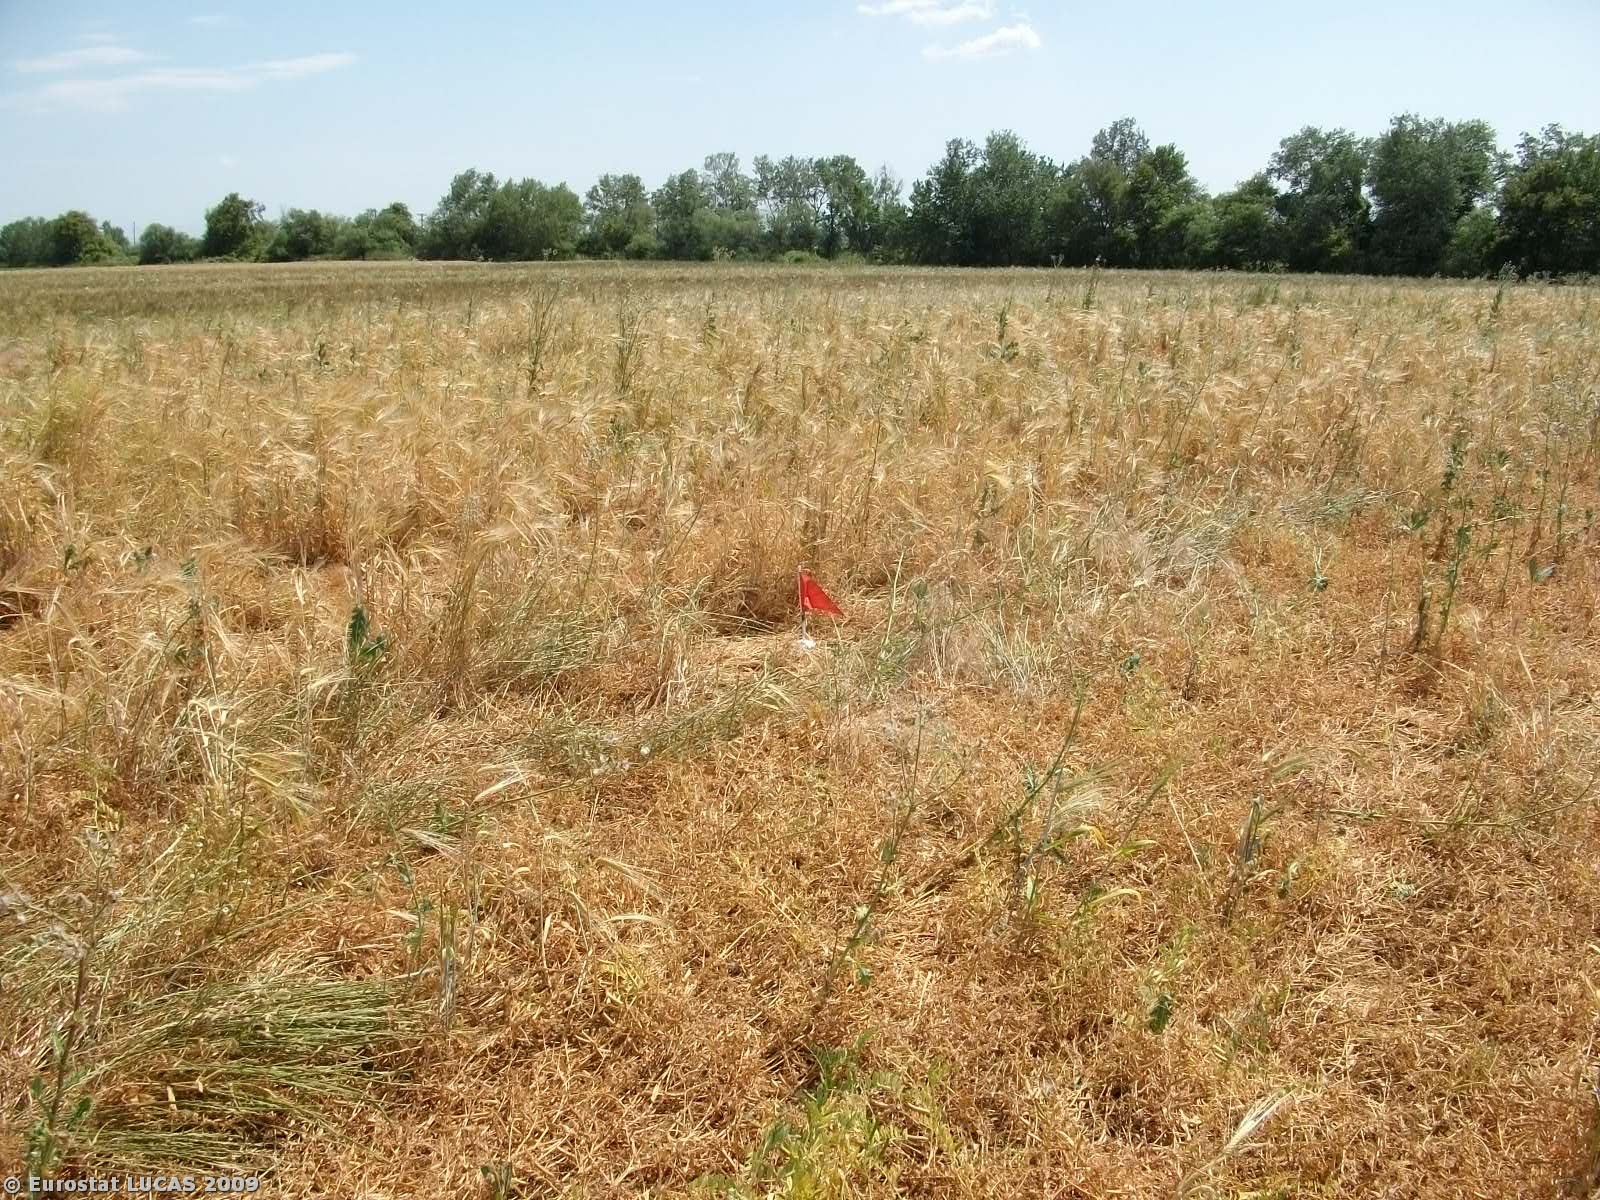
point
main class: Cropland
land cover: Durum wheat
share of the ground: 25 - 50 %
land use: Agriculture (excluding fallow land and kitchen gardens)
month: May
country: GR
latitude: 39.7669
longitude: 22.4239
